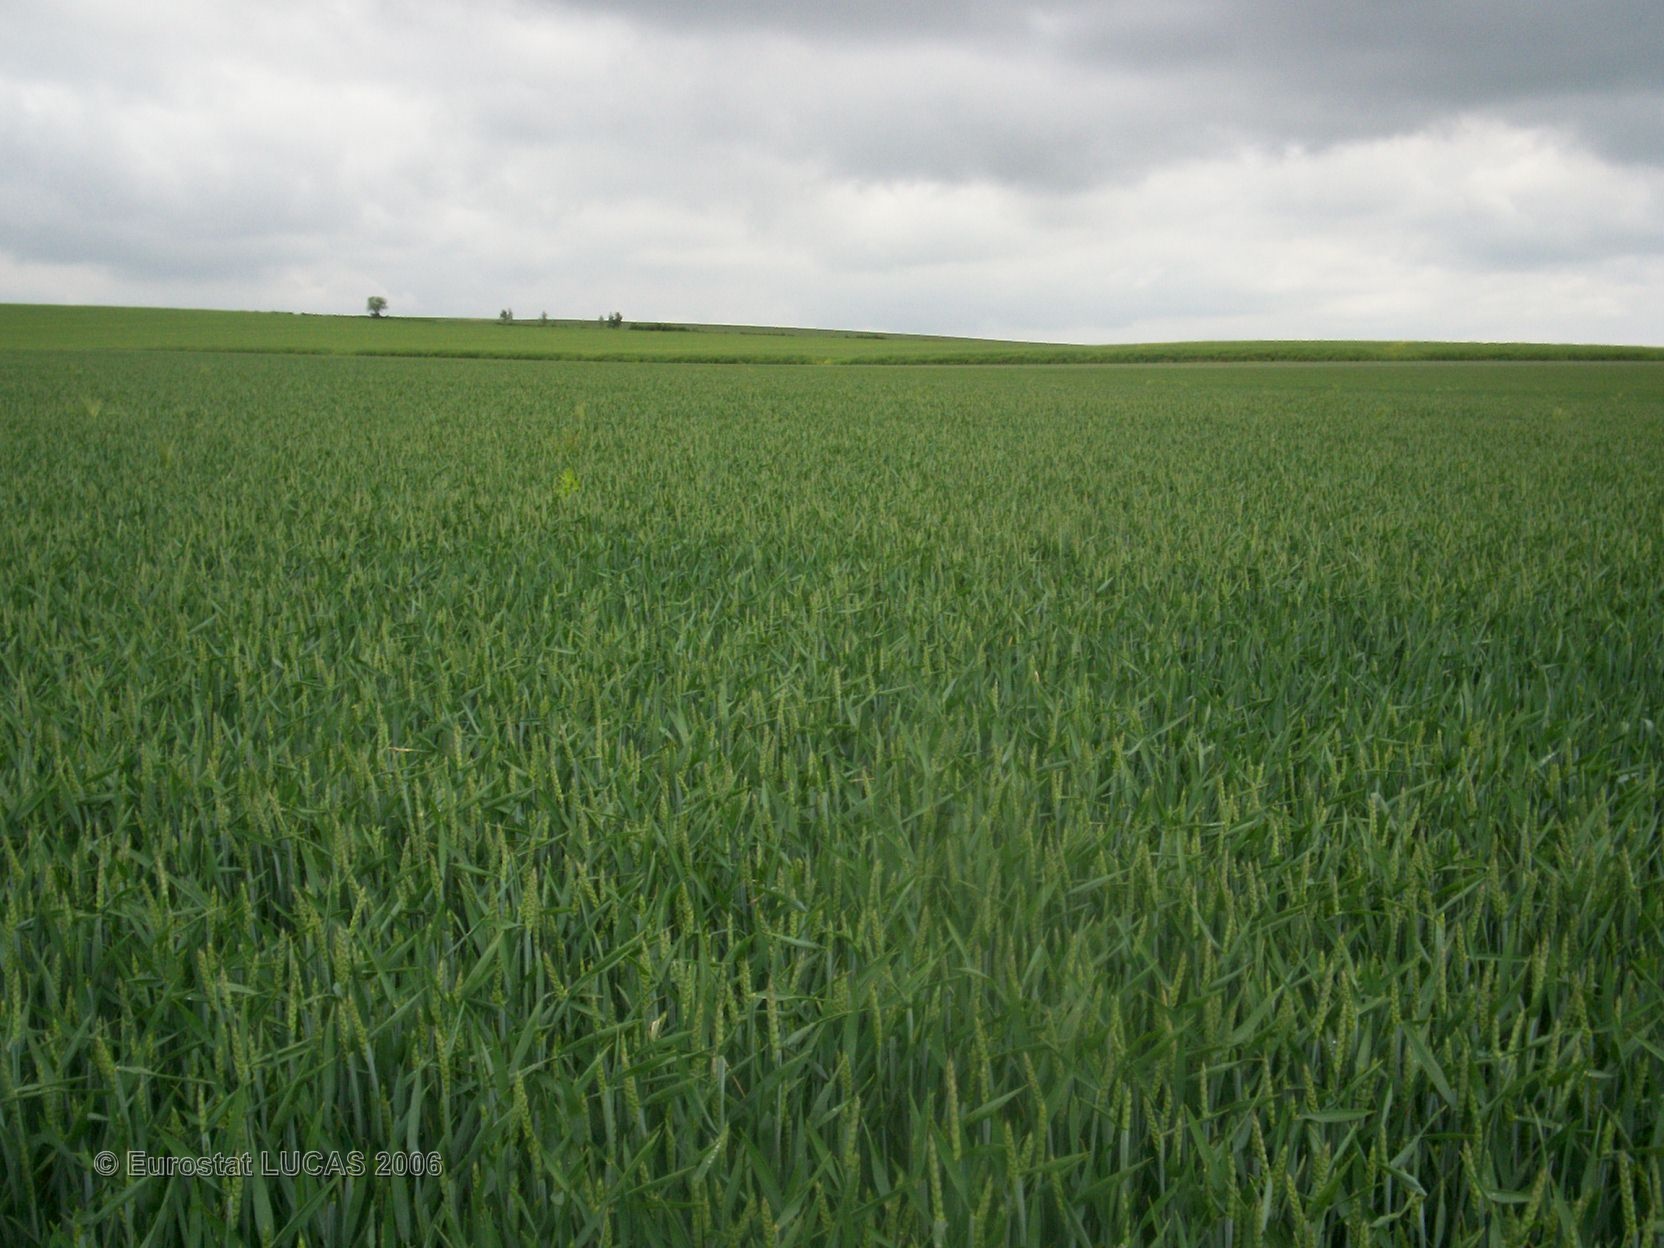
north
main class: Cropland
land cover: Common wheat
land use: Agriculture (excluding fallow land and kitchen gardens)
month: June
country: FR
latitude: 48.5902
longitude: 4.4790
